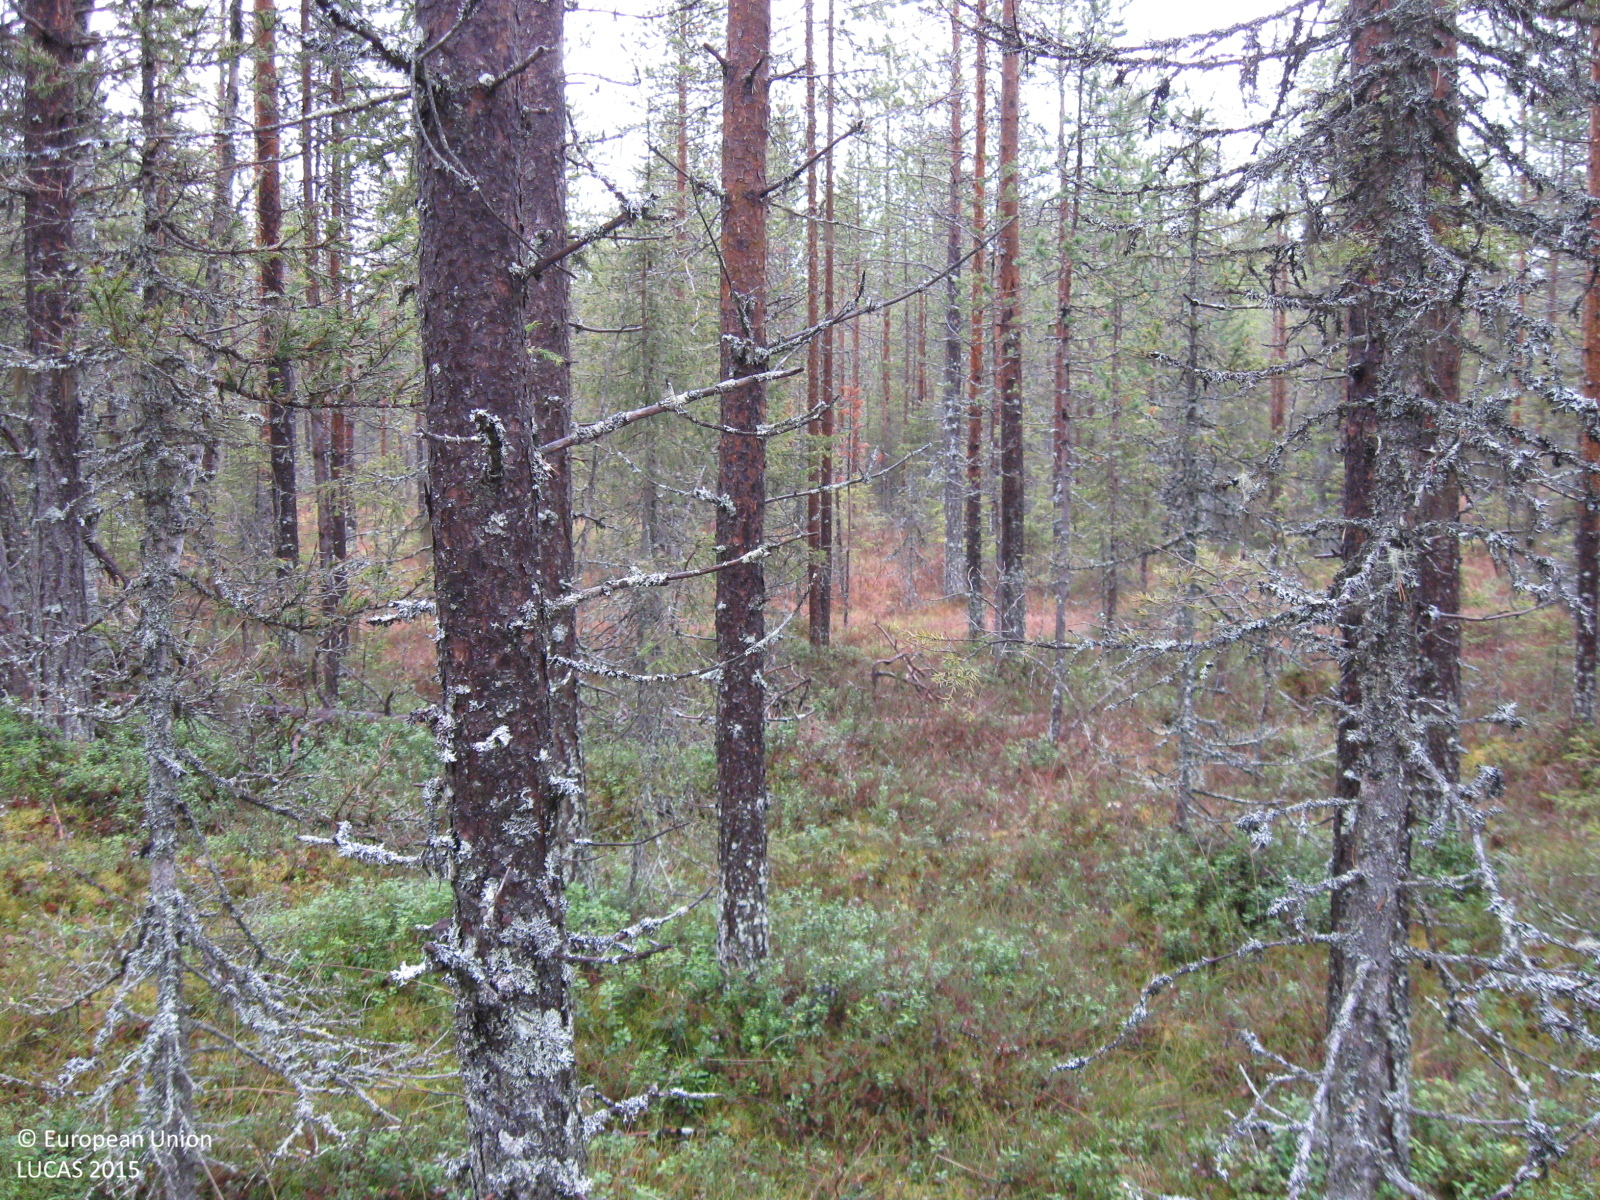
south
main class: Woodland
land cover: Other coniferous woodland
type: boreal forest
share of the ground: > 75 %
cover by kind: coniferous forest trees 70 %, broadleaved forest trees 10 %, shrubs 10 %, herbaceous plants 5 %, lichens and mosses 5 %
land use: Forestry
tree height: > 5 m
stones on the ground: 10 - 25 %
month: October
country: SE
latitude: 66.6926
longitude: 21.7167
